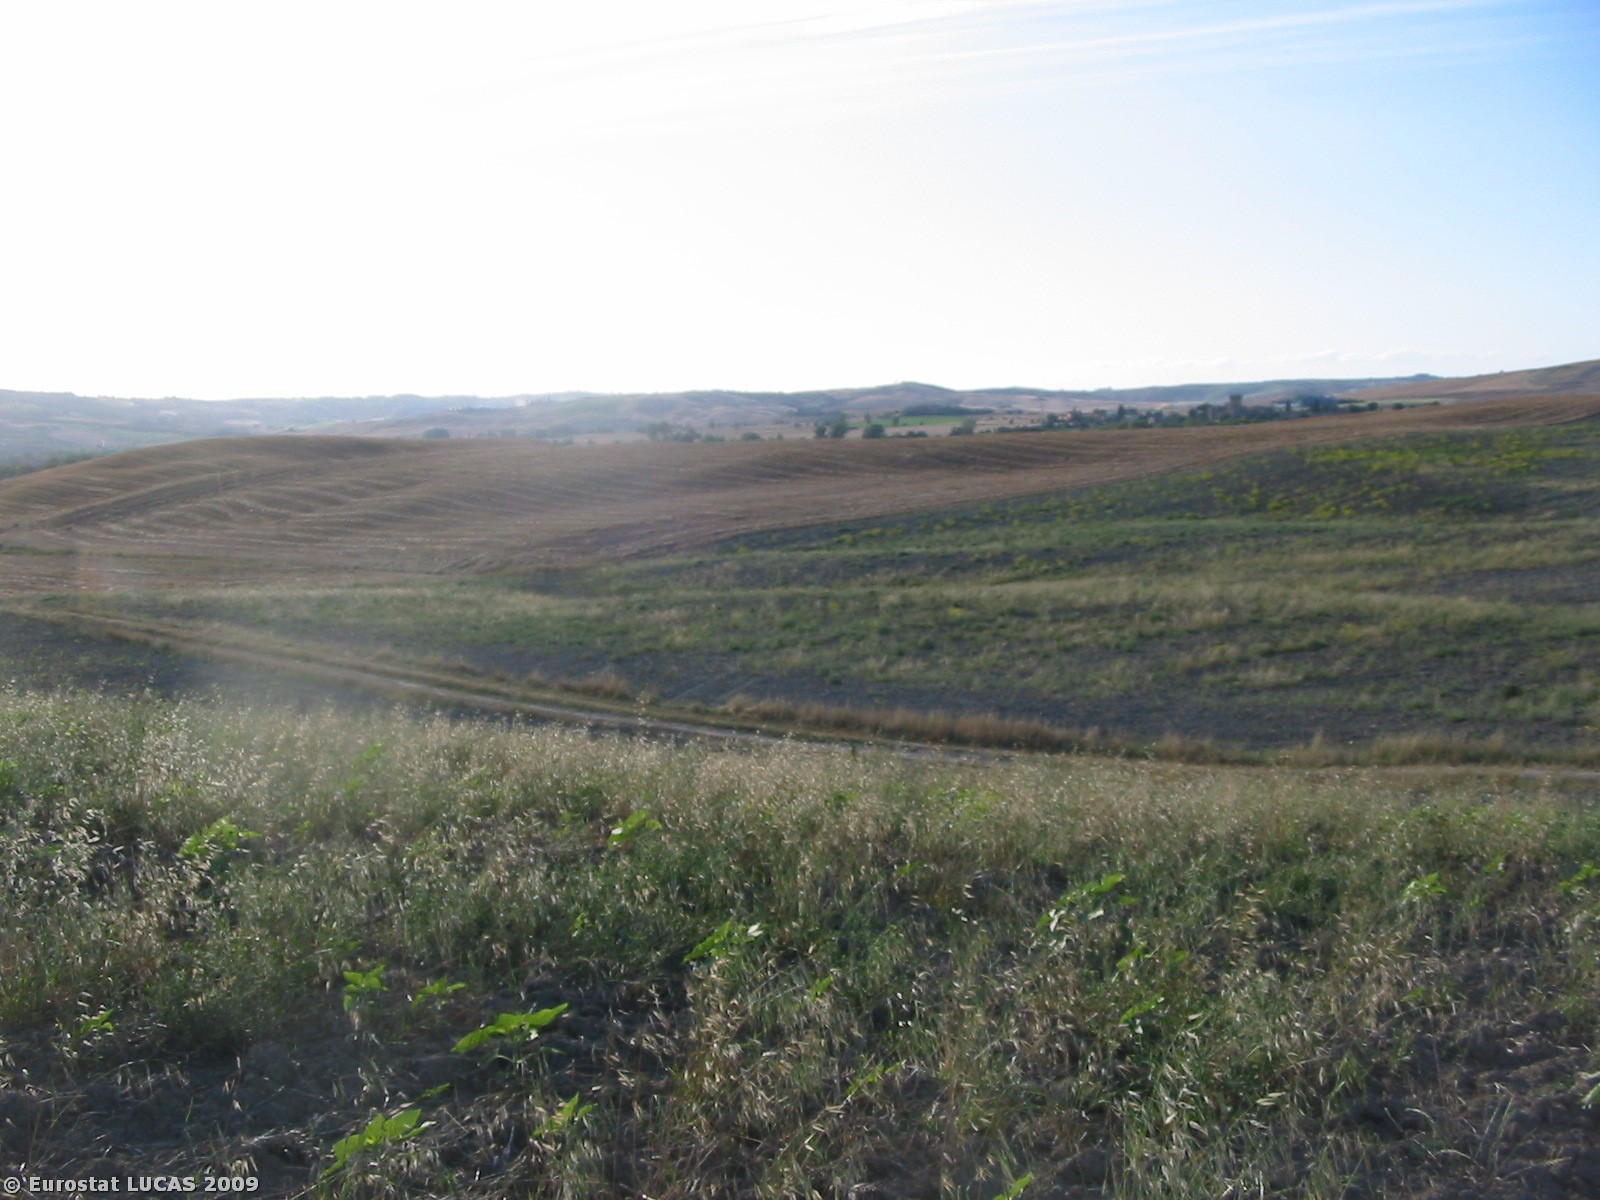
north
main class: Cropland
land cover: Sunflower
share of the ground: 10 - 25 %
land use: Agriculture (excluding fallow land and kitchen gardens)
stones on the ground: < 10 %
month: July
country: IT
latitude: 43.0194
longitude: 11.6760
